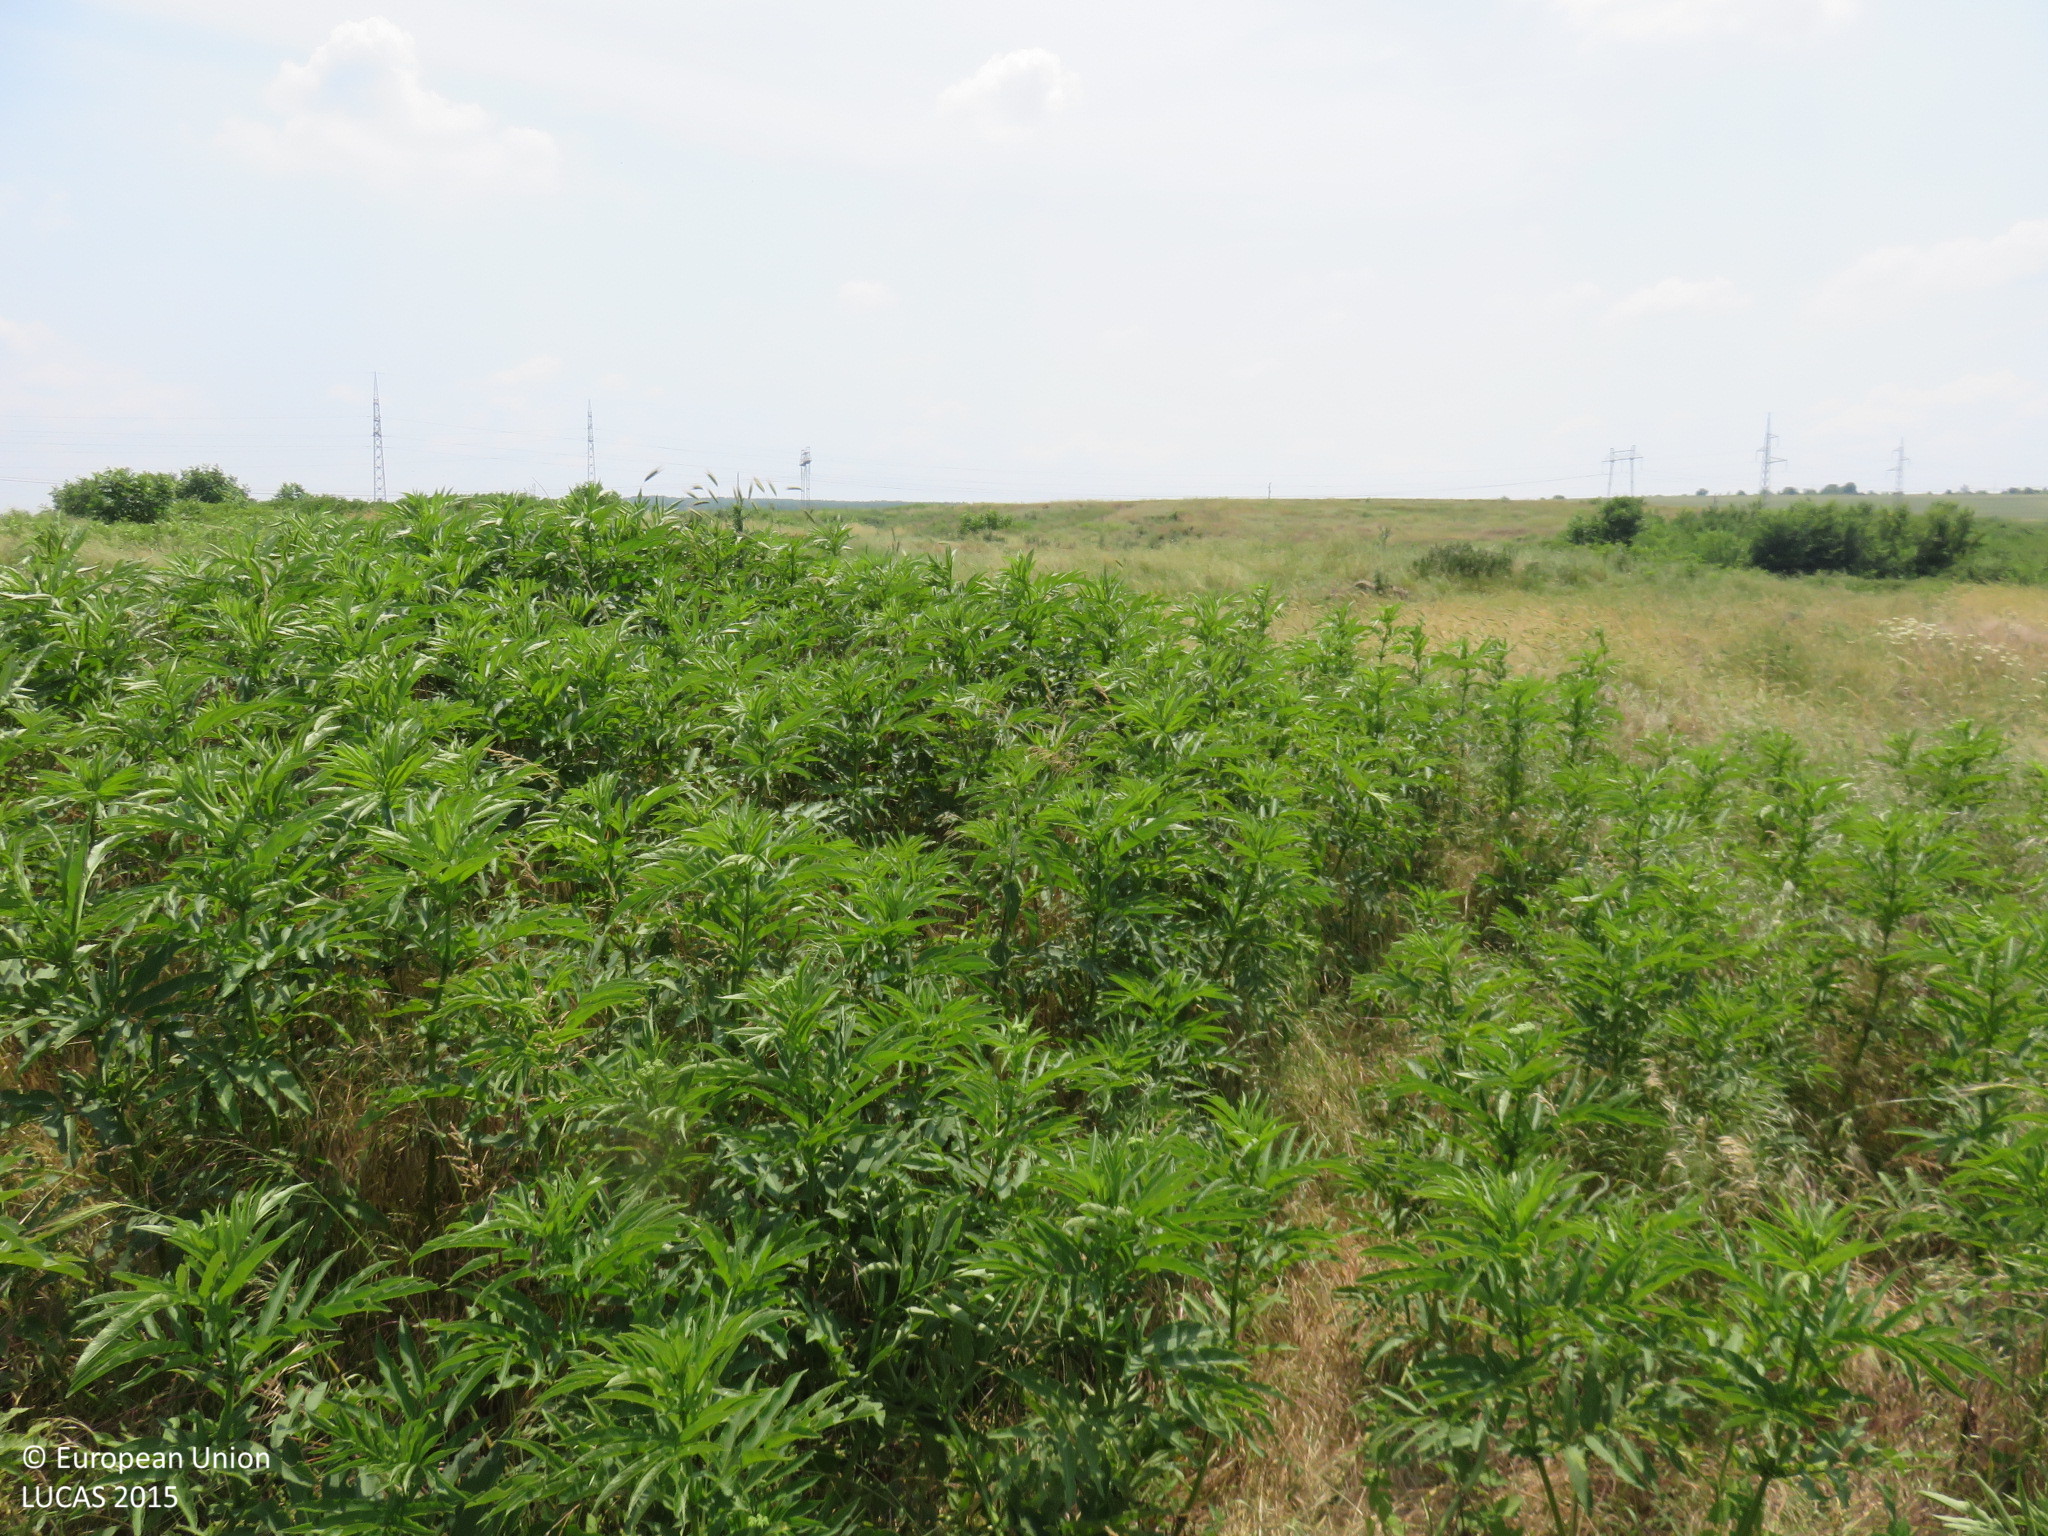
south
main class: Grassland
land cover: Grassland without tree/shrub cover
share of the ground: > 75 %
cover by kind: herbaceous plants 100 %
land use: Agriculture (excluding fallow land and kitchen gardens)
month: June
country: BG
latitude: 43.3787
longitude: 24.5141
